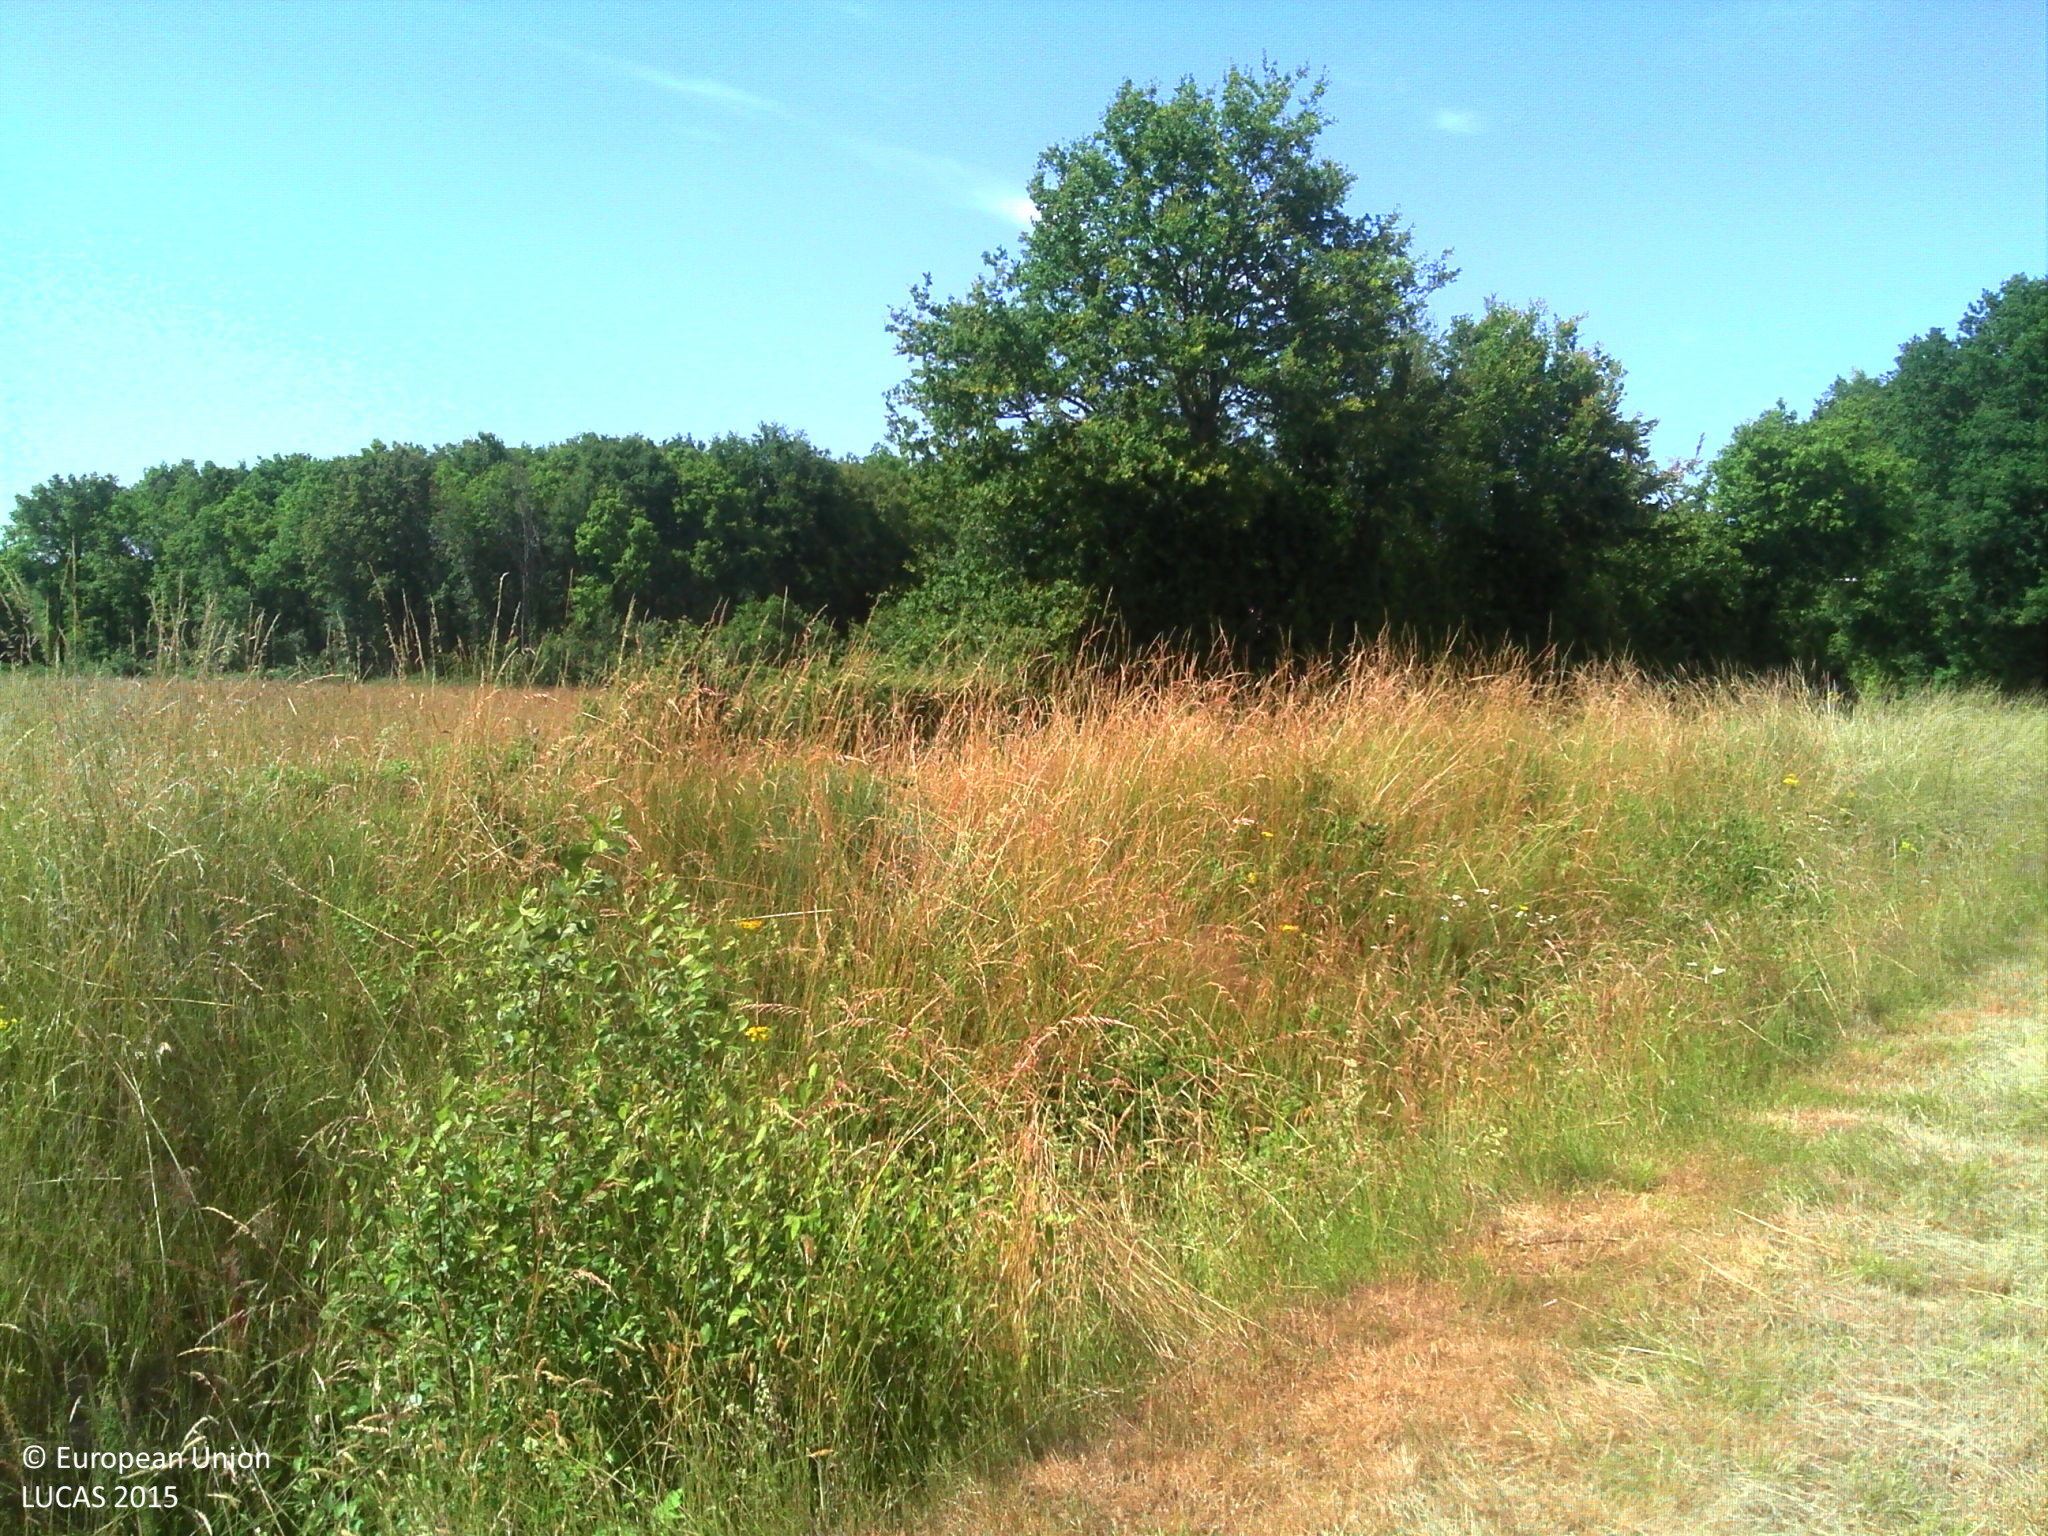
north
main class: Grassland
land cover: Grassland without tree/shrub cover
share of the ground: > 75 %
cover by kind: herbaceous plants 100 %
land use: Air transport
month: June
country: FR
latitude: 47.3629
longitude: 2.9104
